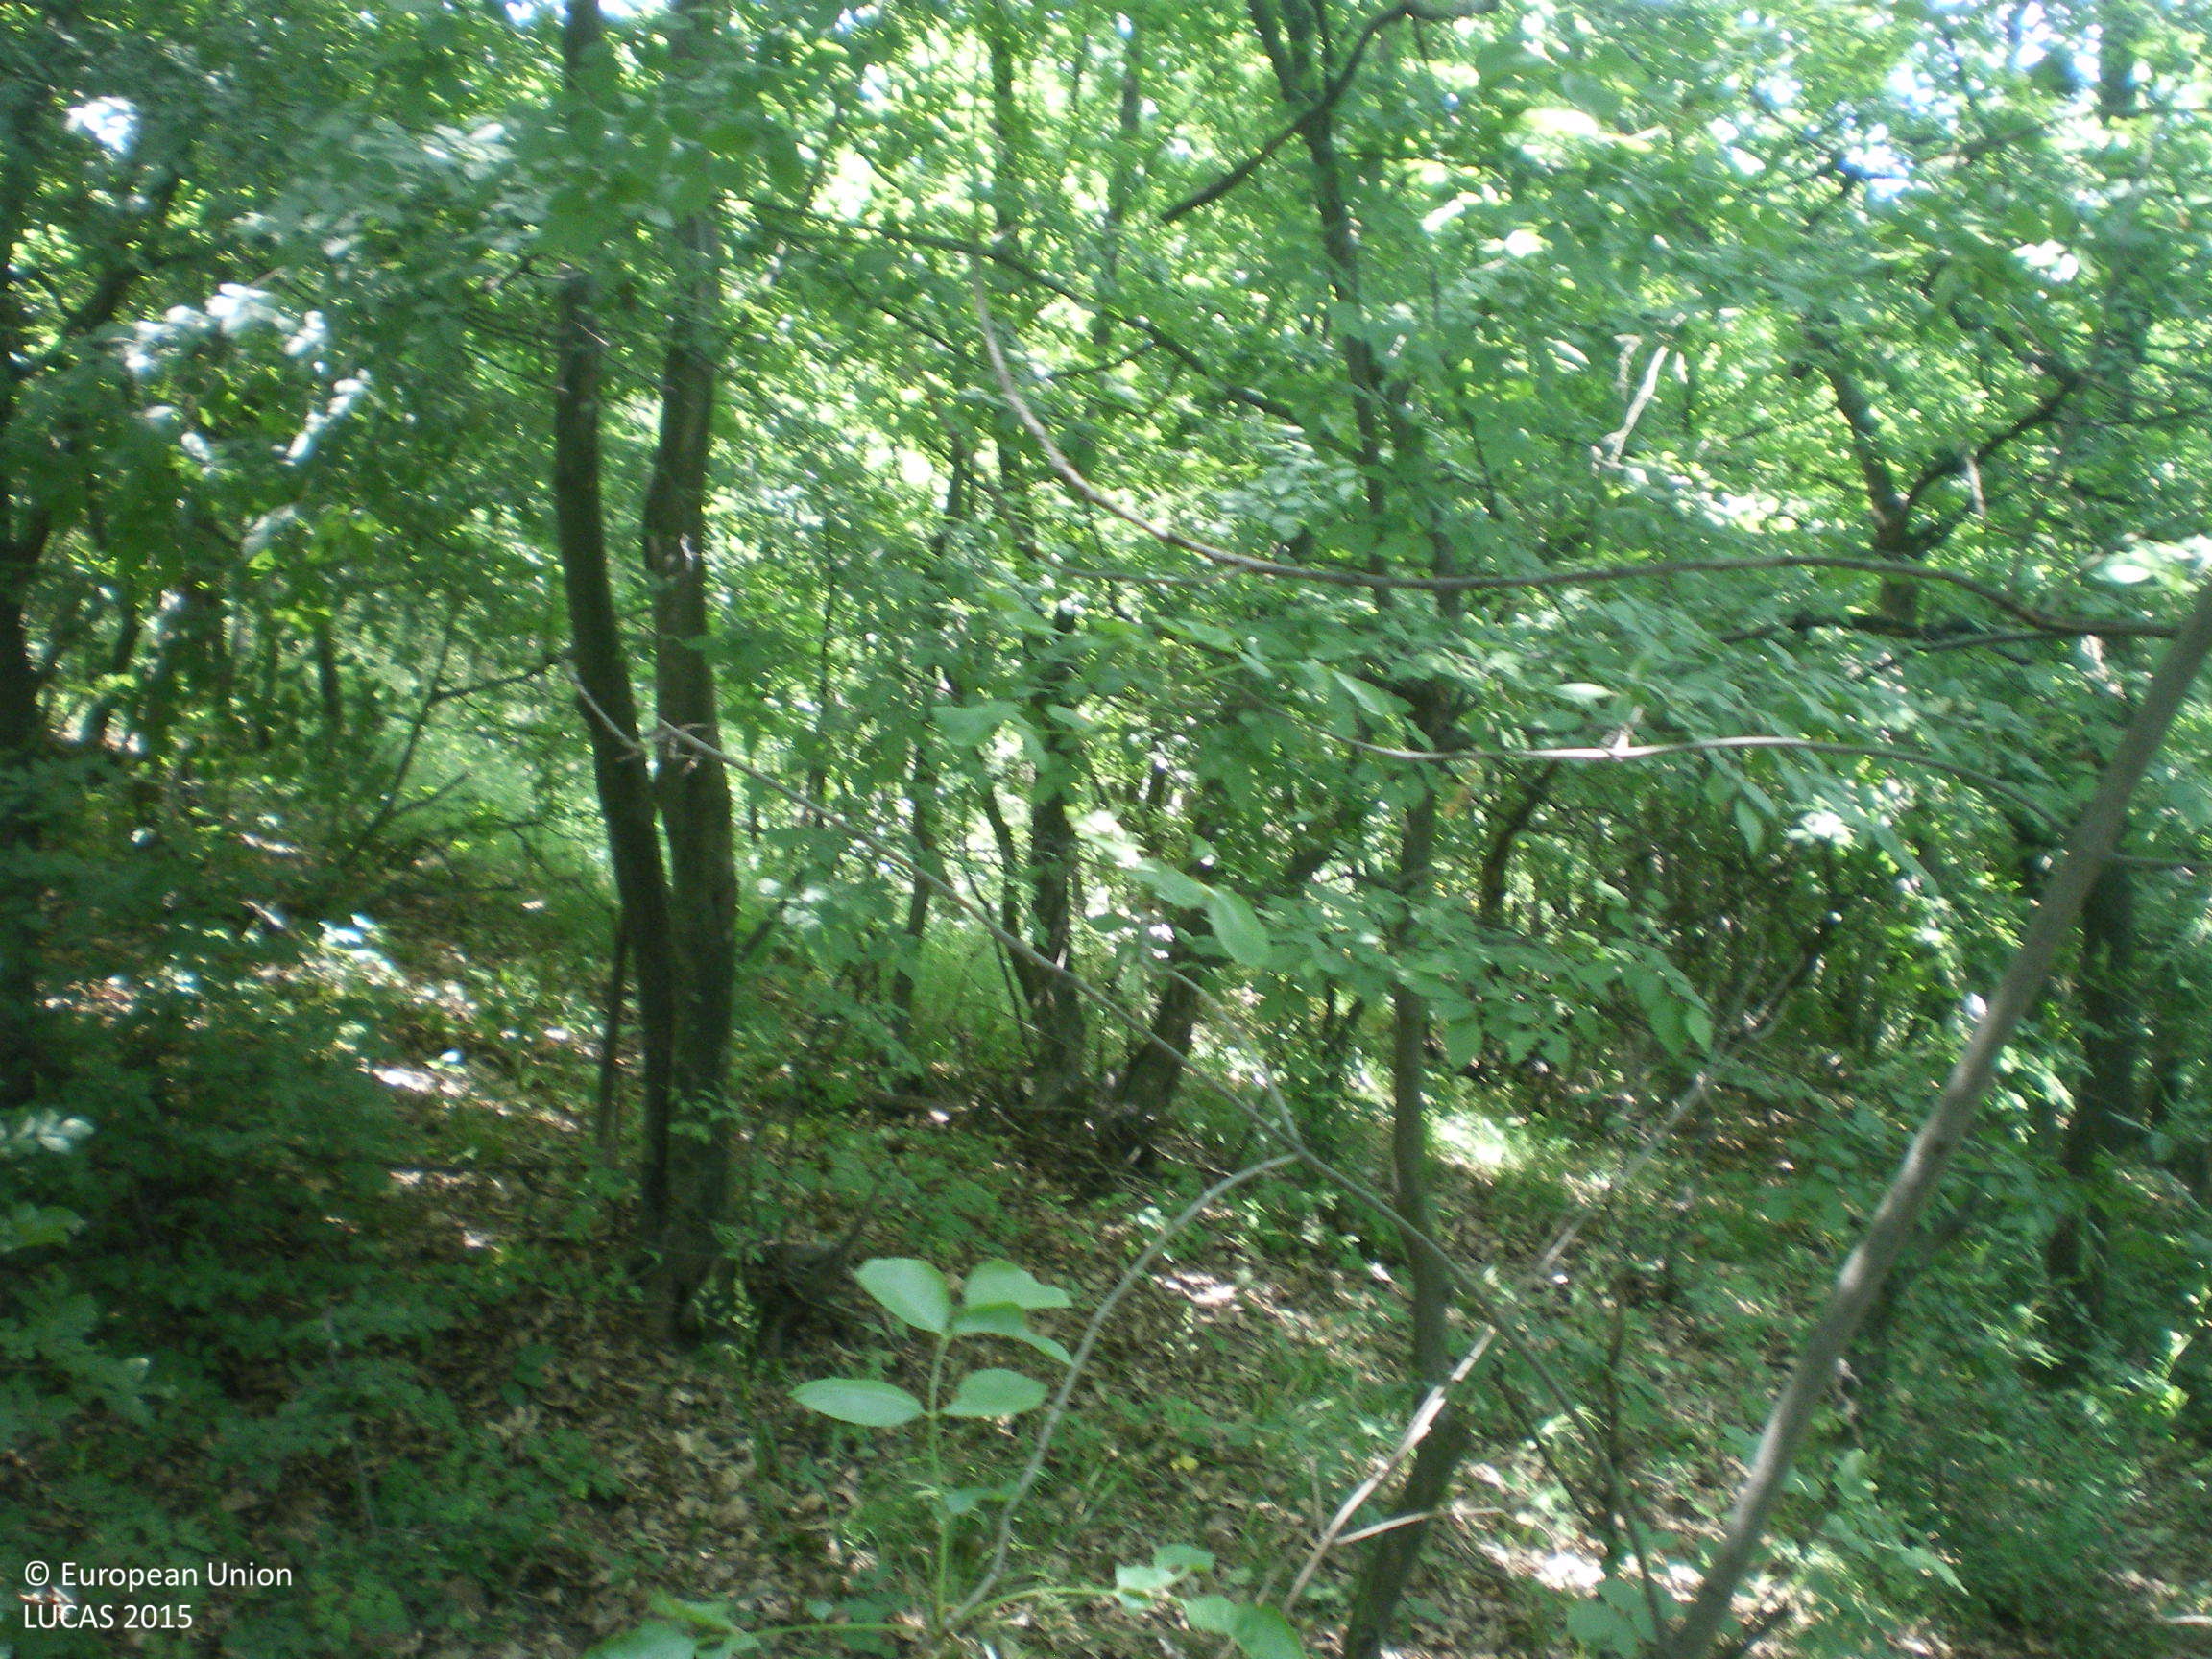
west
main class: Woodland
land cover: Broadleaved woodland
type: mesophytic deciduous forest
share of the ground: > 75 %
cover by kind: broadleaved forest trees 80 %, shrubs 15 %, herbaceous plants 5 %
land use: Forestry
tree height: > 5 m
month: June
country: BG
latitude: 42.3976
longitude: 25.5597
